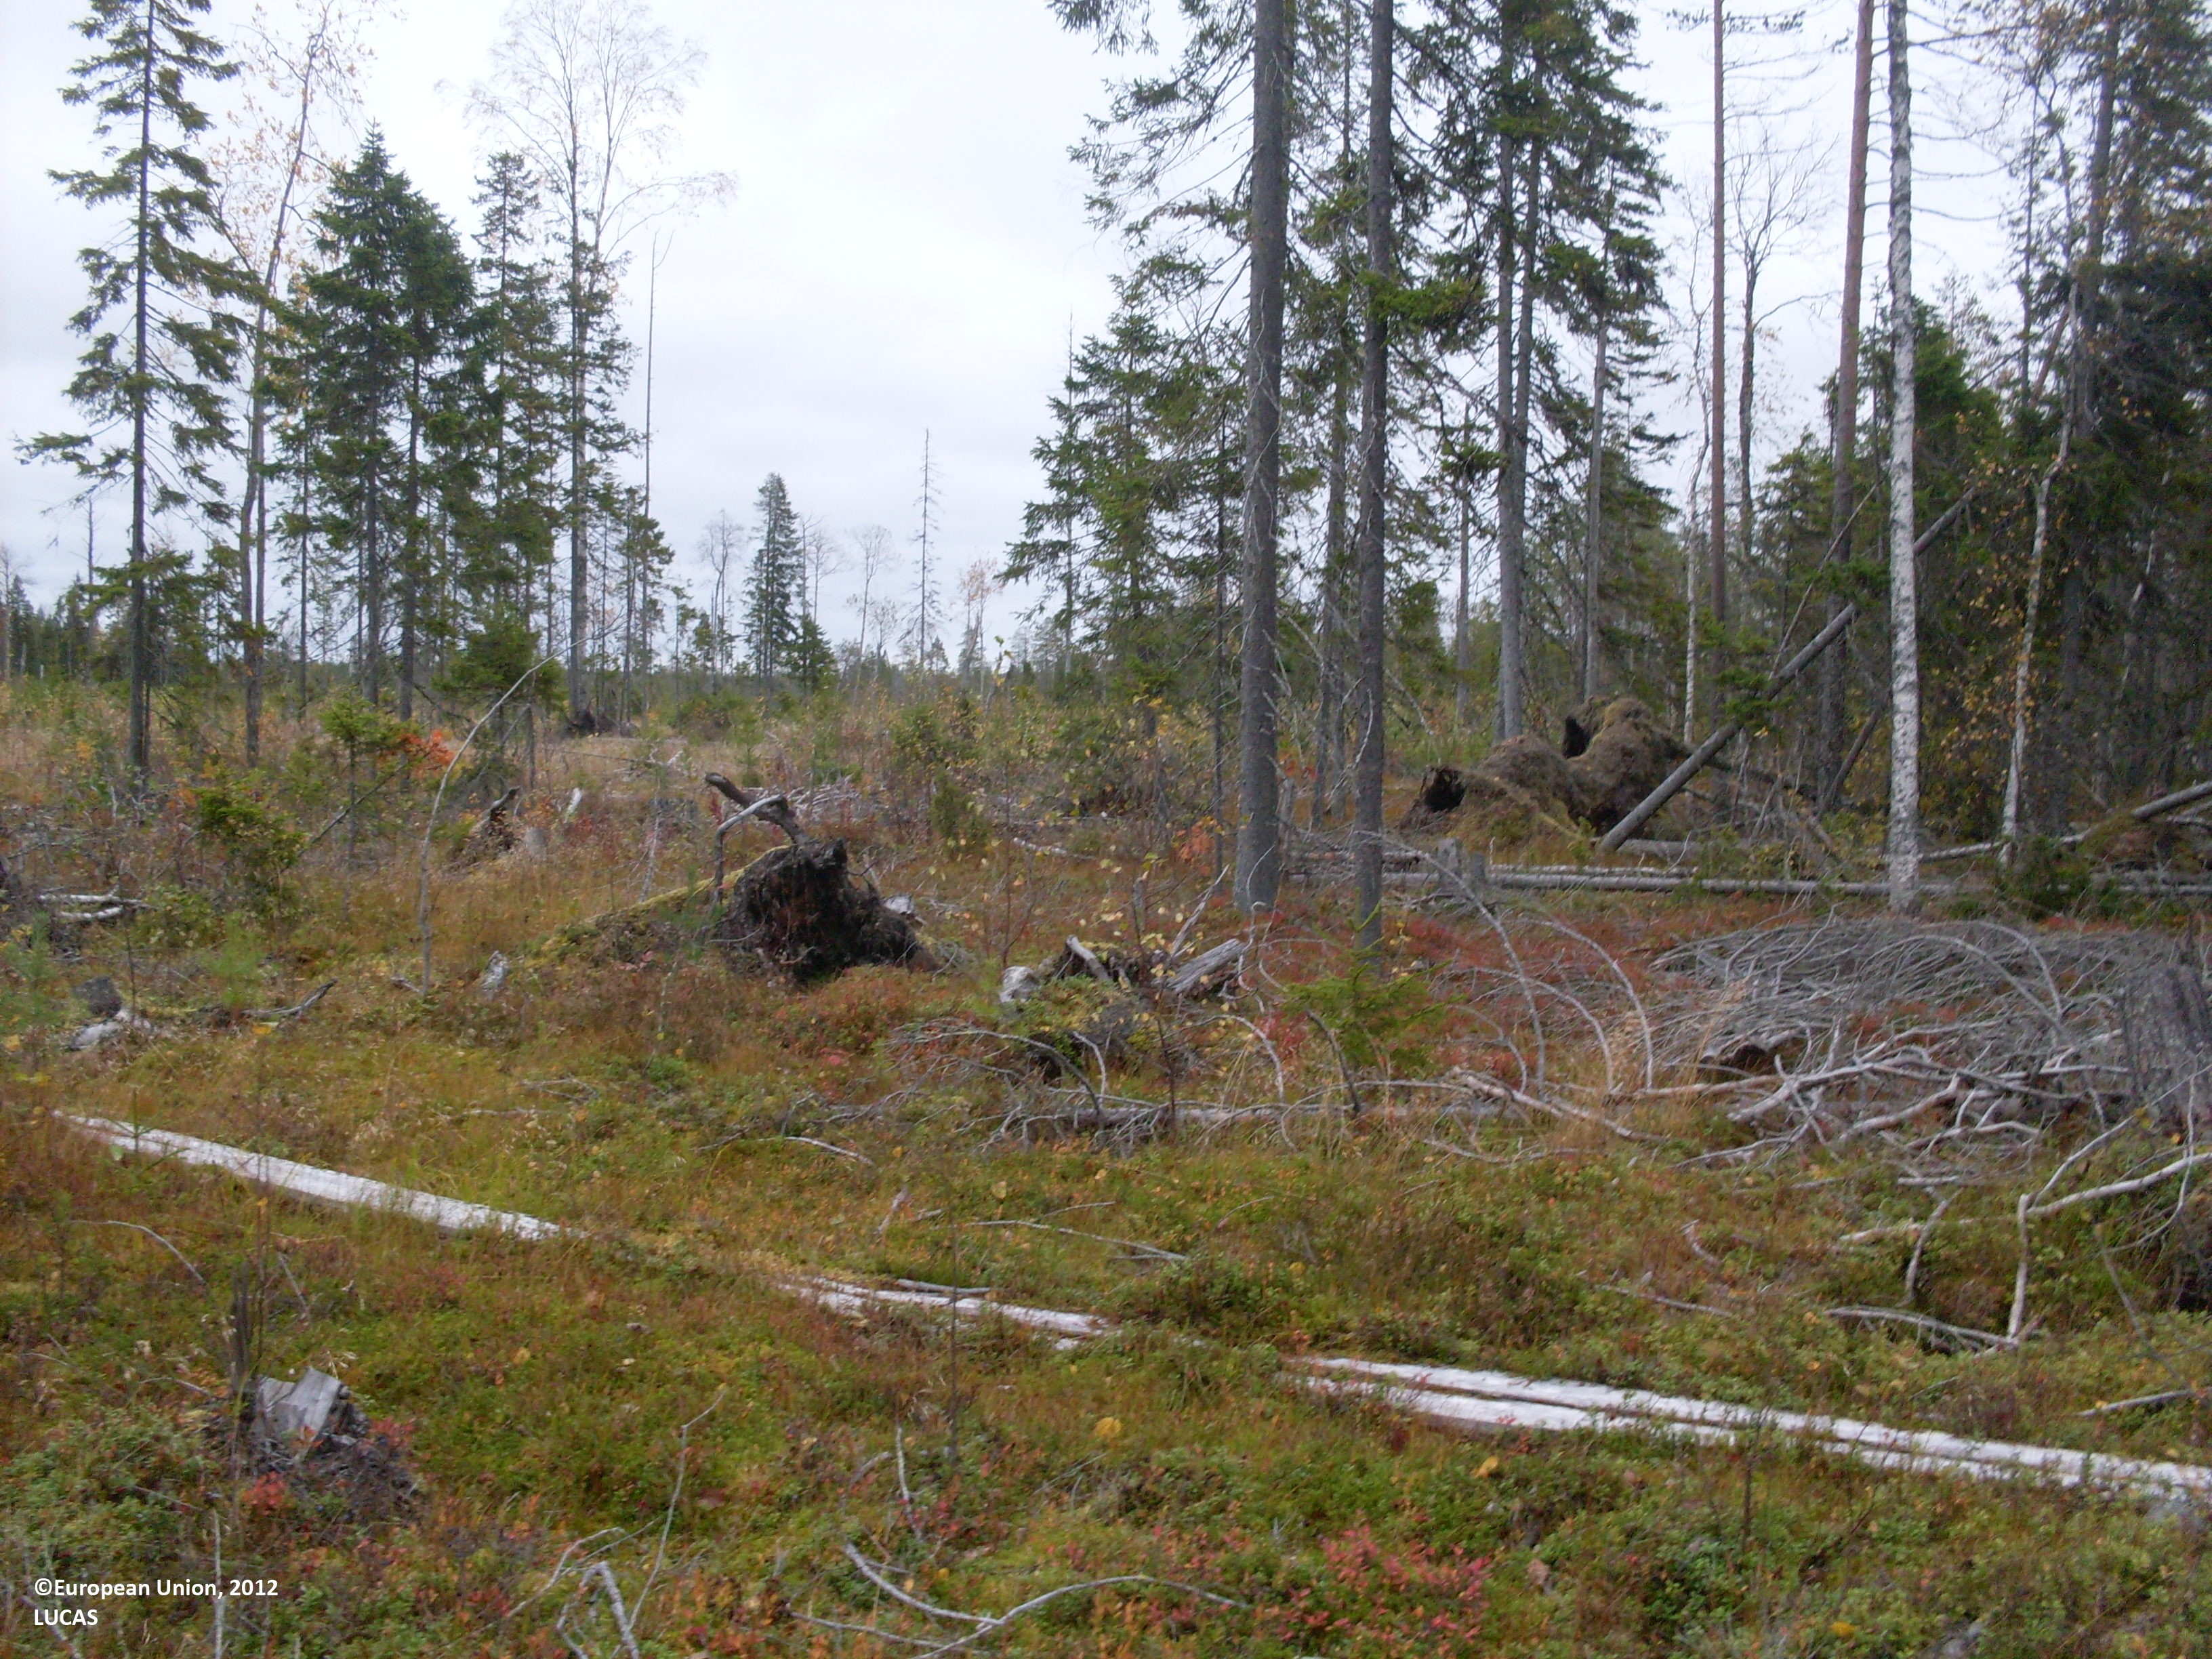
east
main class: Shrubland
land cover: Shrubland with sparse tree cover
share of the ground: 50 - 75 %
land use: Forestry
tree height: > 5 m
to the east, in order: Shrubland with sparse tree cover; Ditches and canals; Shrubland with sparse tree cover; Peatbogs
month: September
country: FI
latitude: 64.4147
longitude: 30.0141
